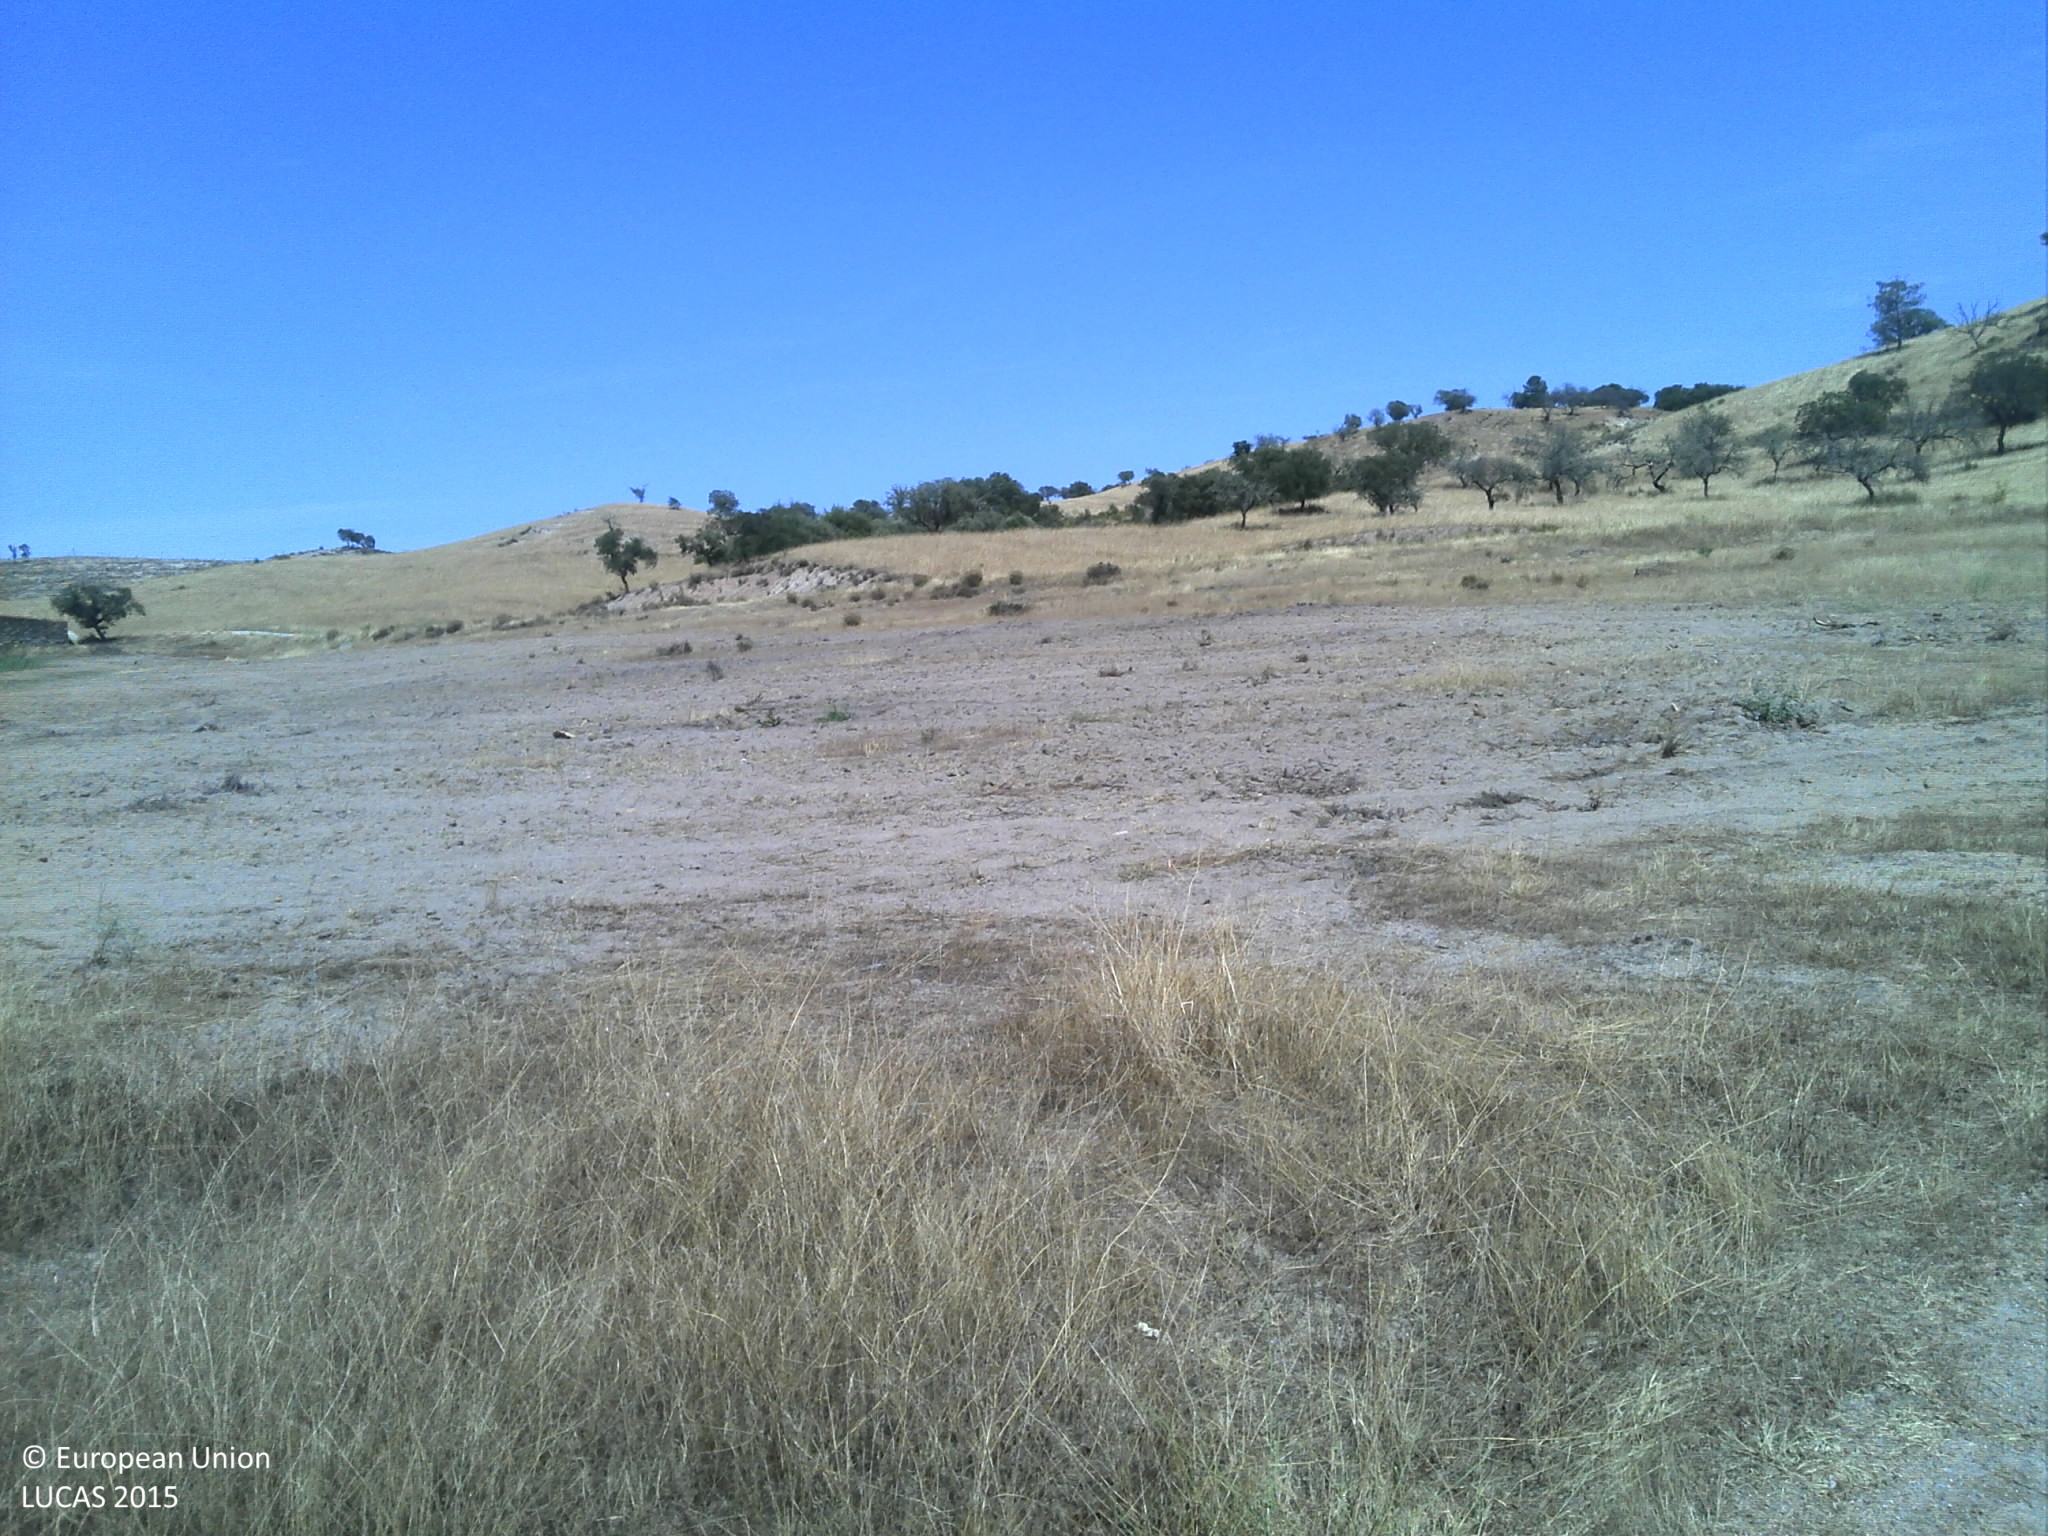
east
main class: Grassland
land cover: Spontaneously vegetated surfaces
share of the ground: 25 - 50 %
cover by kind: unconsolidated bare surface 50 %, herbaceous plants 45 %
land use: Agriculture (excluding fallow land and kitchen gardens)
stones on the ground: 10 - 25 %
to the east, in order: Spontaneously vegetated surfaces; Other bare soil; Spontaneously vegetated surfaces; Paved roads, cycling and walking lanes; Grassland with sparse tree/shrub cover; Shrubland with sparse tree cover; Artificial constructions; Tracks; Inland fresh water bodies
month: July
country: PT
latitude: 39.6779
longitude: -7.5987
